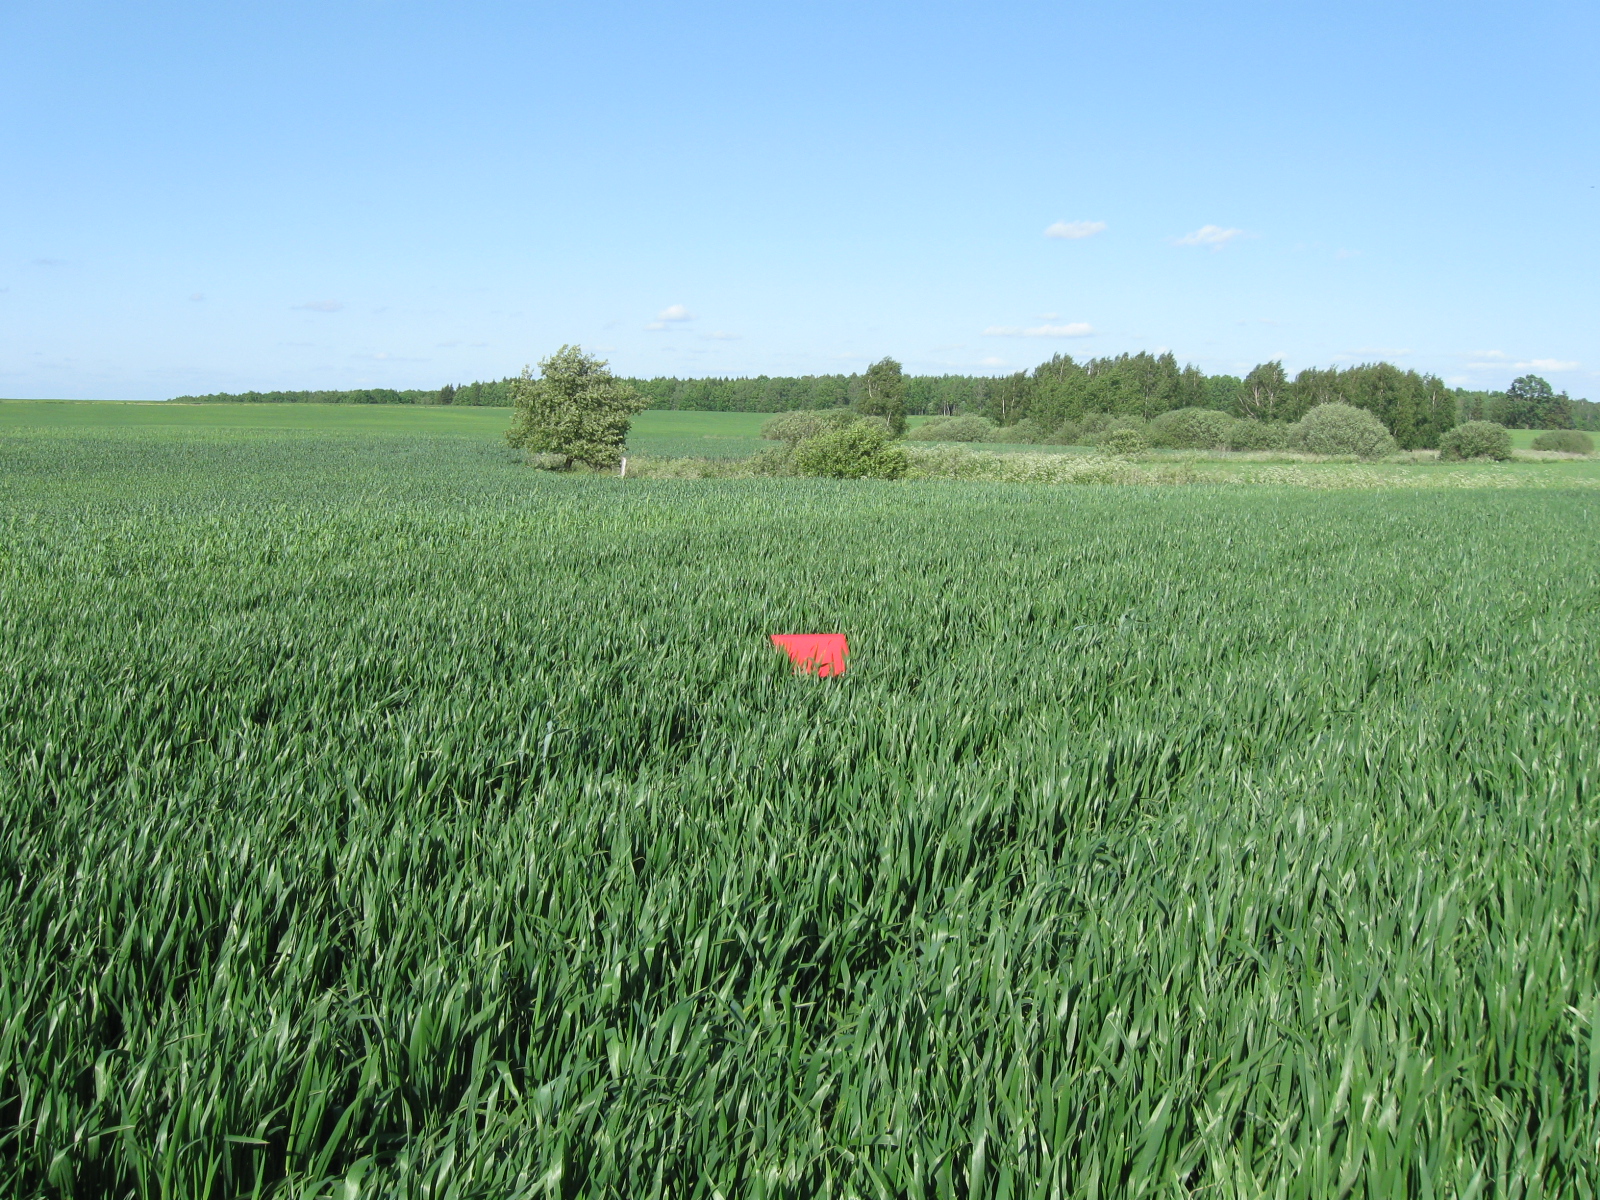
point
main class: Cropland
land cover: Common wheat
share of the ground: > 75 %
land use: Agriculture (excluding fallow land and kitchen gardens)
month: June
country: LT
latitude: 54.4577
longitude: 23.7383
